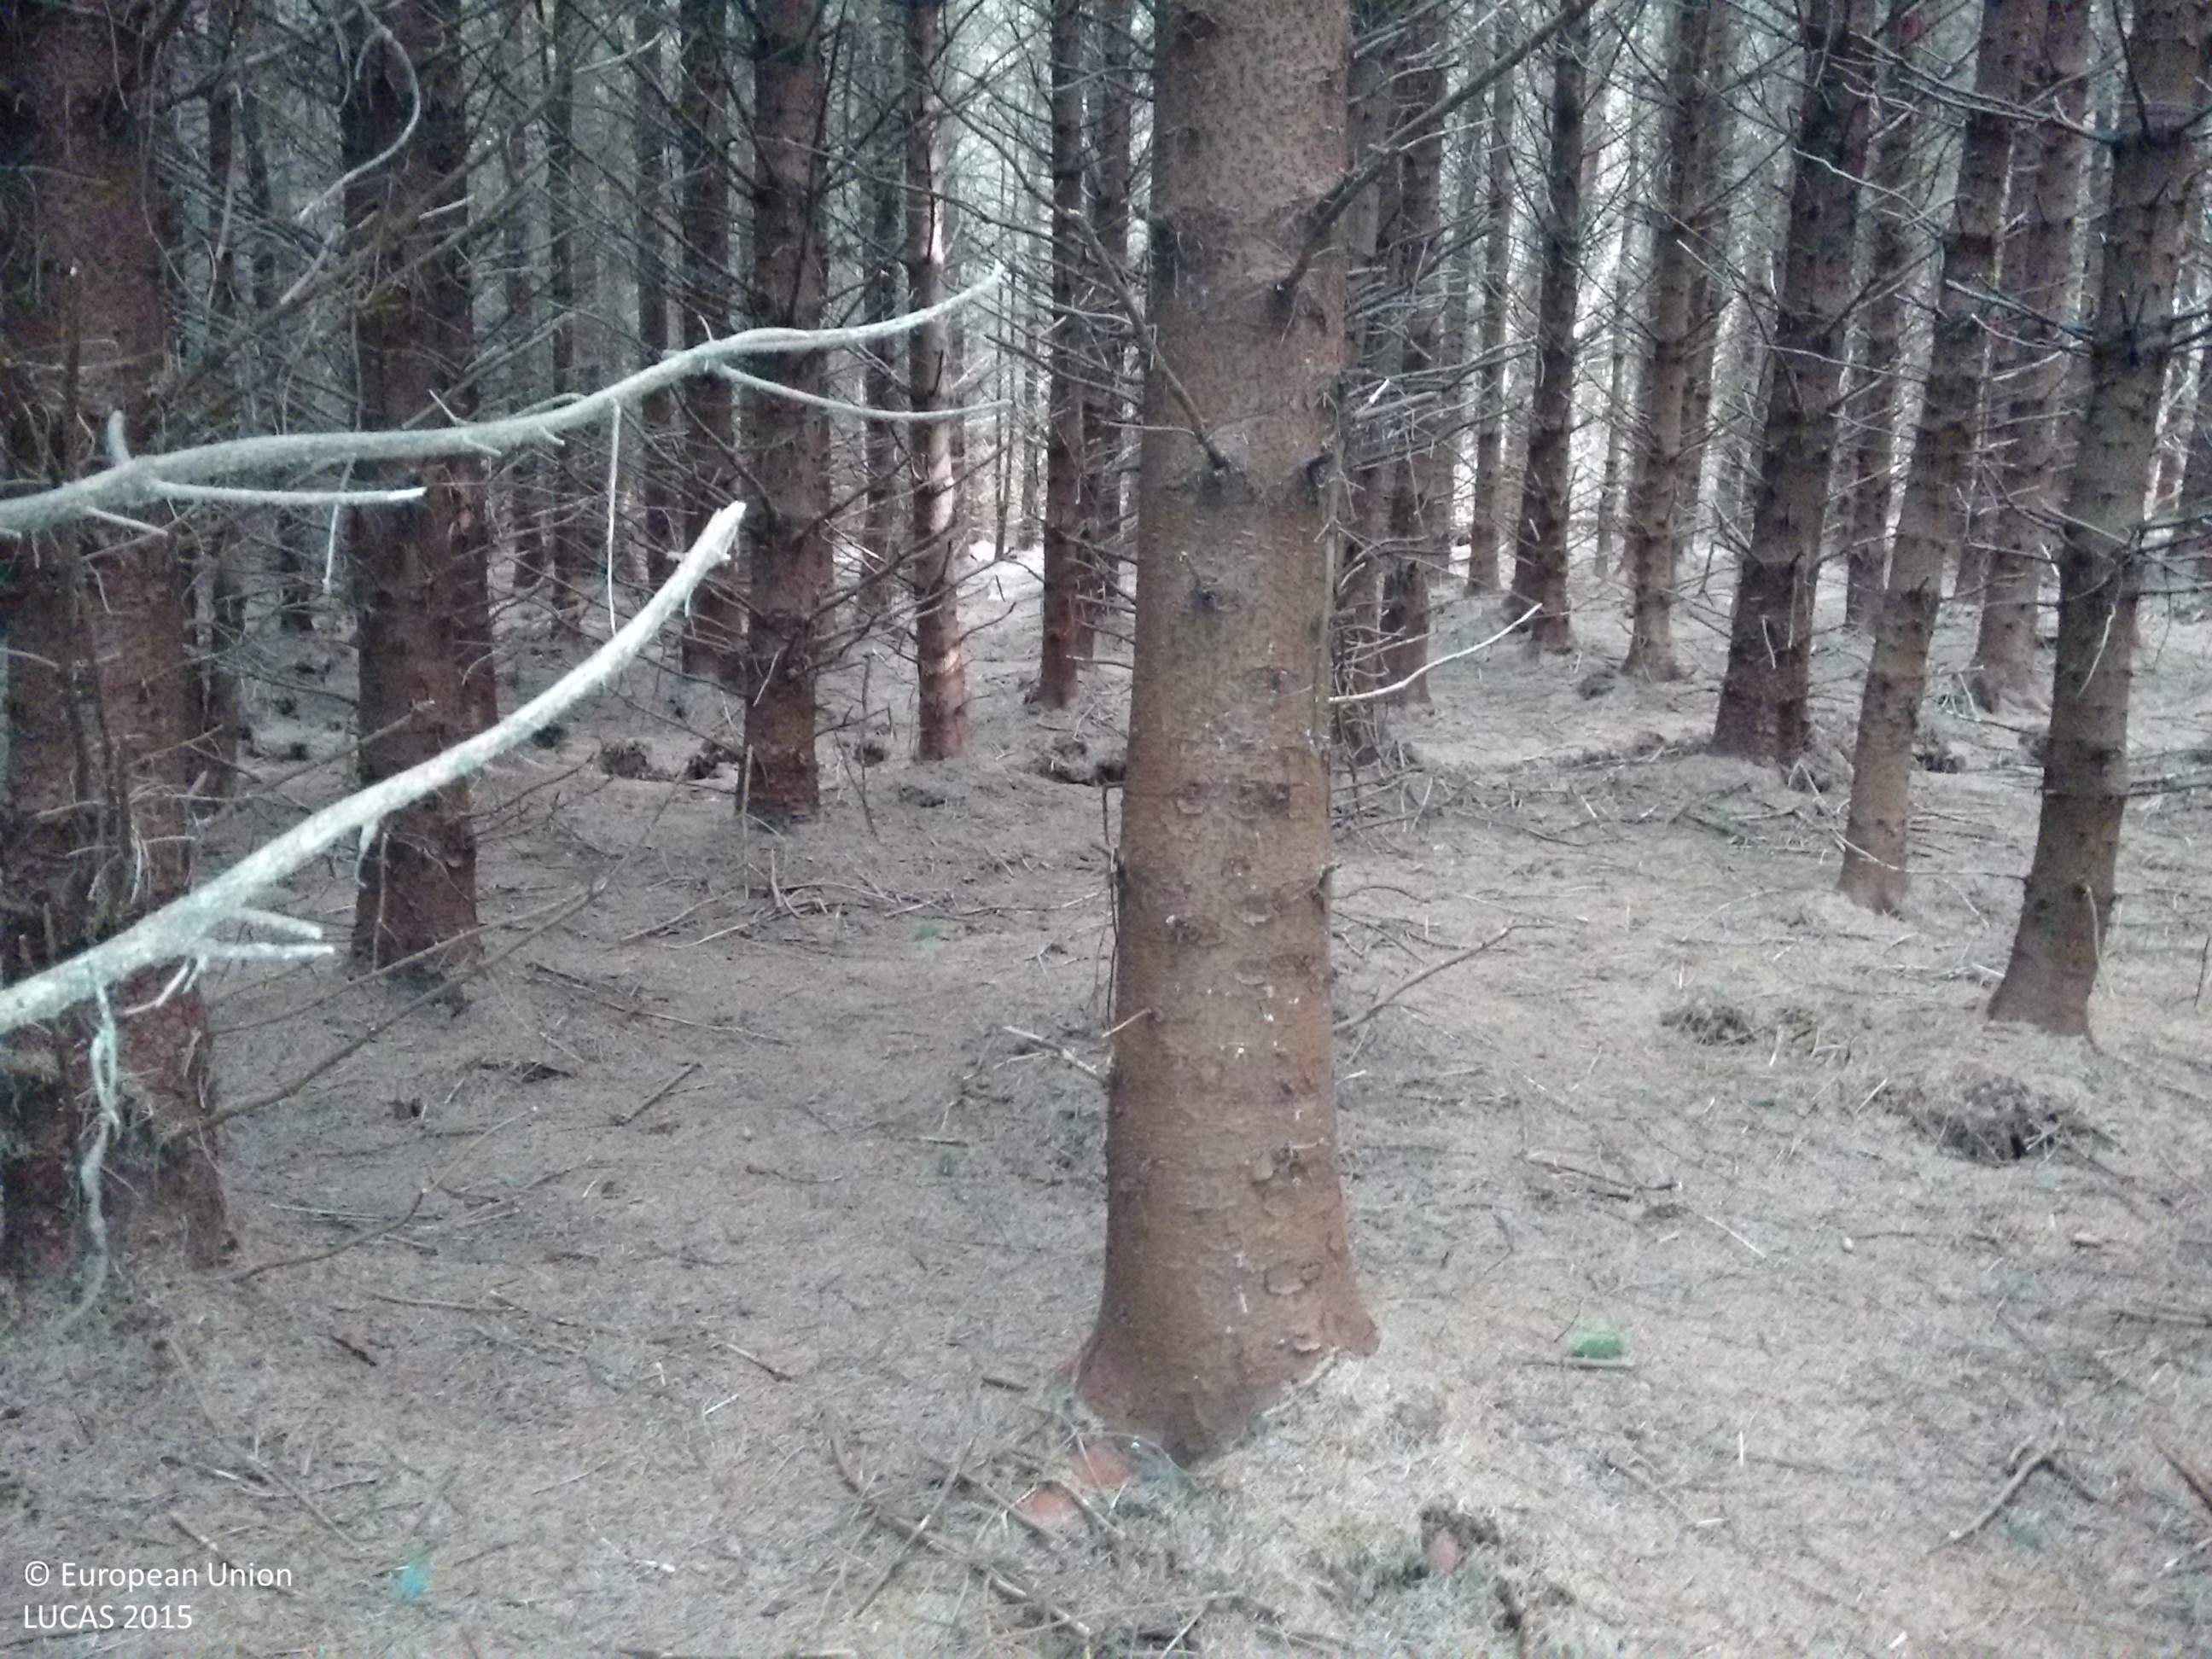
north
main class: Woodland
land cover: Spruce dominated coniferous woodland
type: exotic forest
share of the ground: > 75 %
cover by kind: coniferous forest trees 100 %
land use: Forestry
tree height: > 5 m
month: September
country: IE
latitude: 52.2065
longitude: -9.3529
